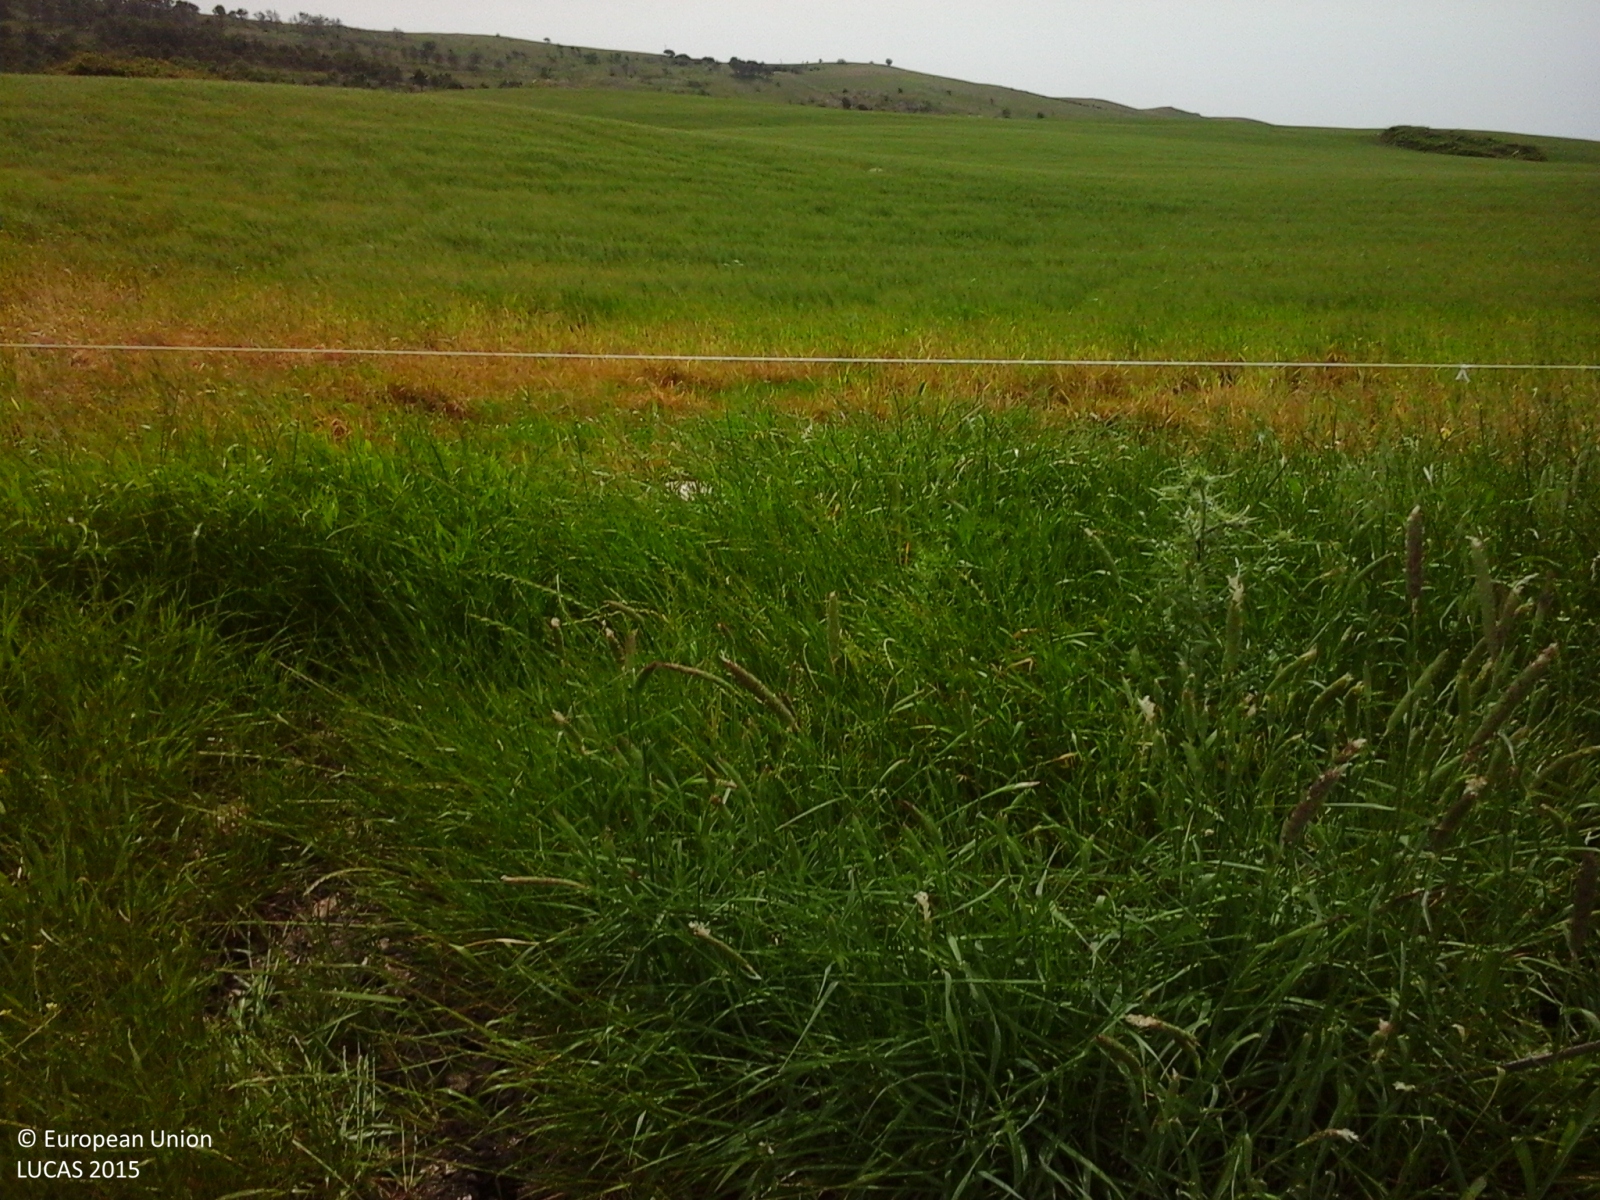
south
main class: Cropland
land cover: Durum wheat
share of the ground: > 75 %
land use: Agriculture (excluding fallow land and kitchen gardens)
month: May
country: IT
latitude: 37.7013
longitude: 13.5015
